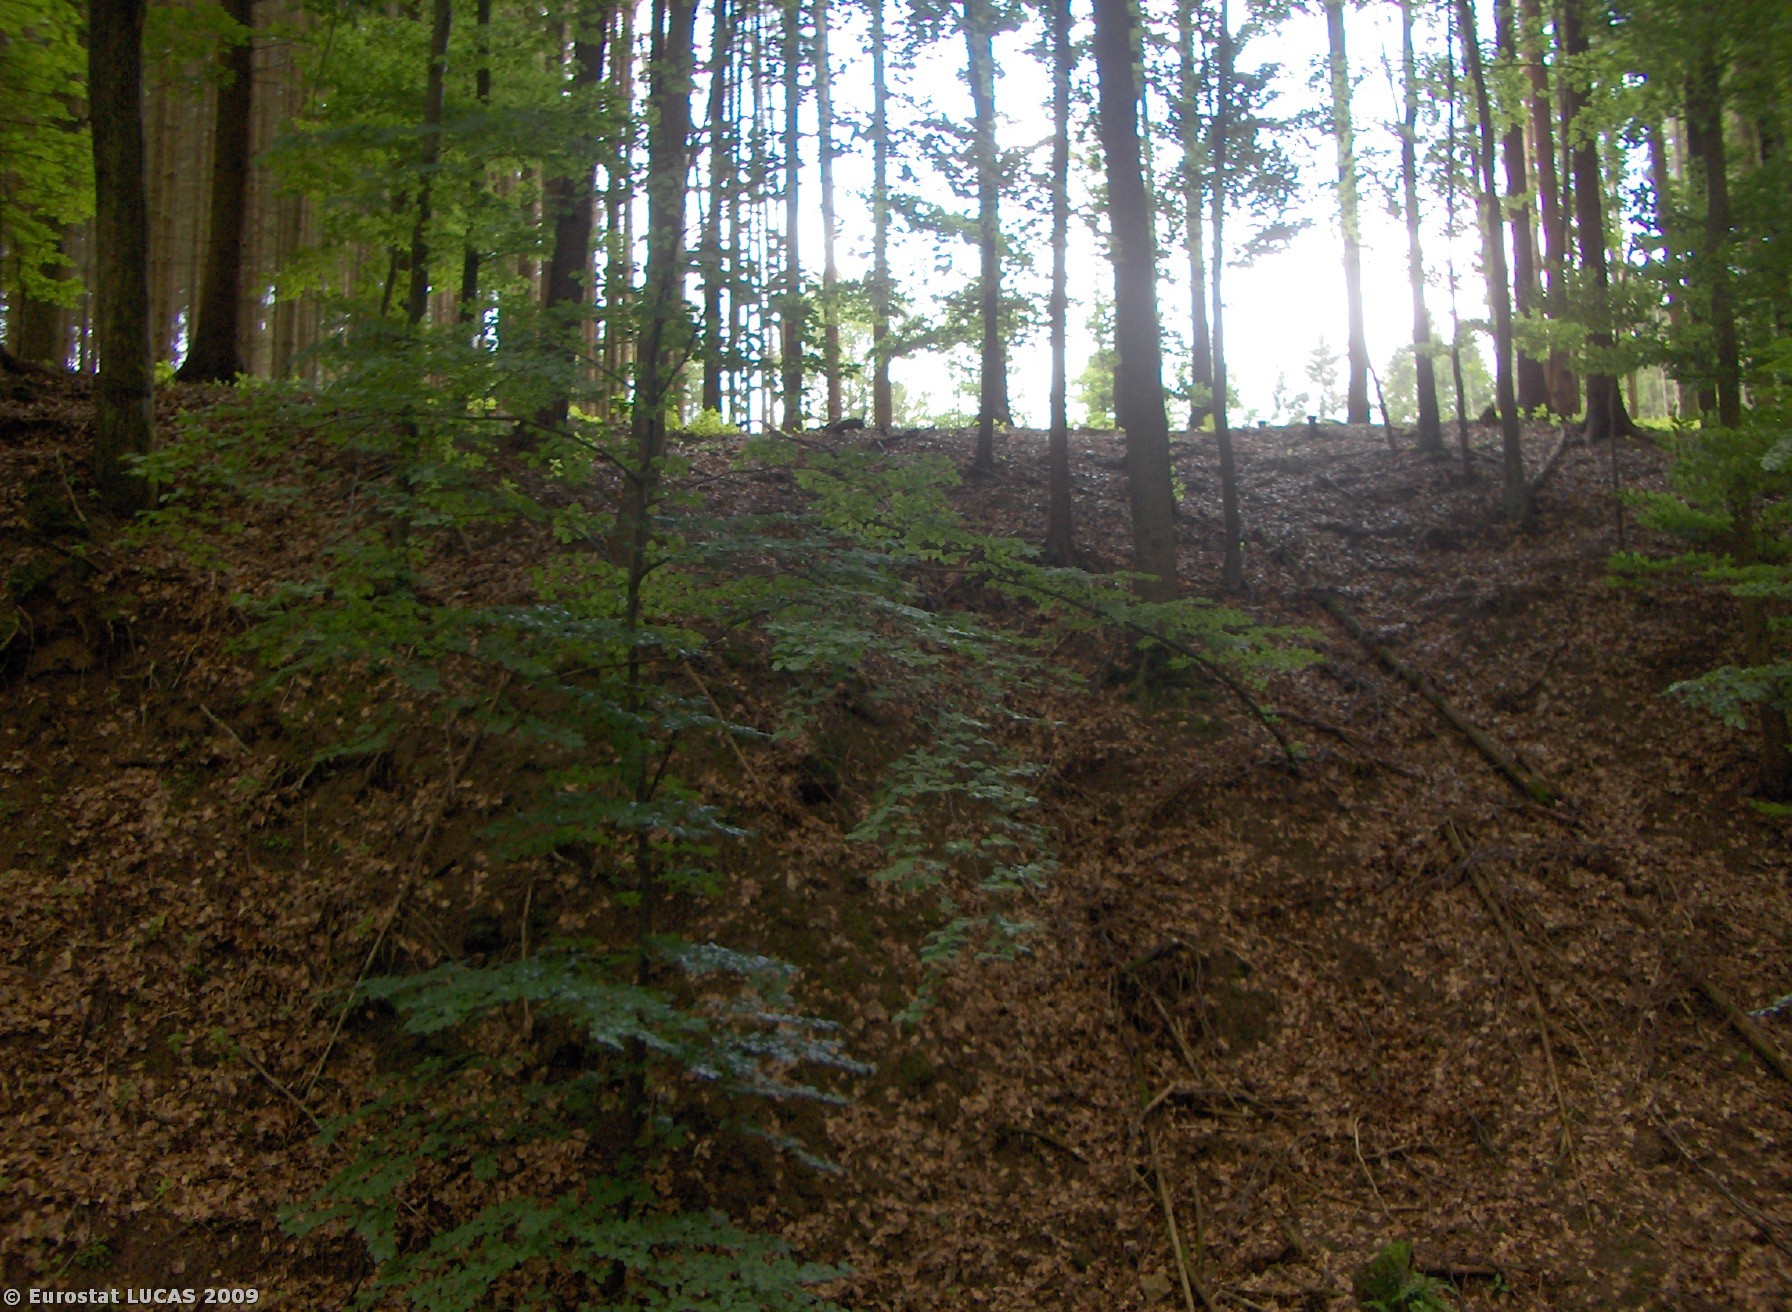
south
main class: Woodland
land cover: Coniferous woodland
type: hemiboreal forest and nemoral coniferous forest and mixed broadleaved-coniferous forest
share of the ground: > 75 %
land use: Forestry
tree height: > 5 m
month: June
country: CZ
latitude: 49.2915
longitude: 14.3322
